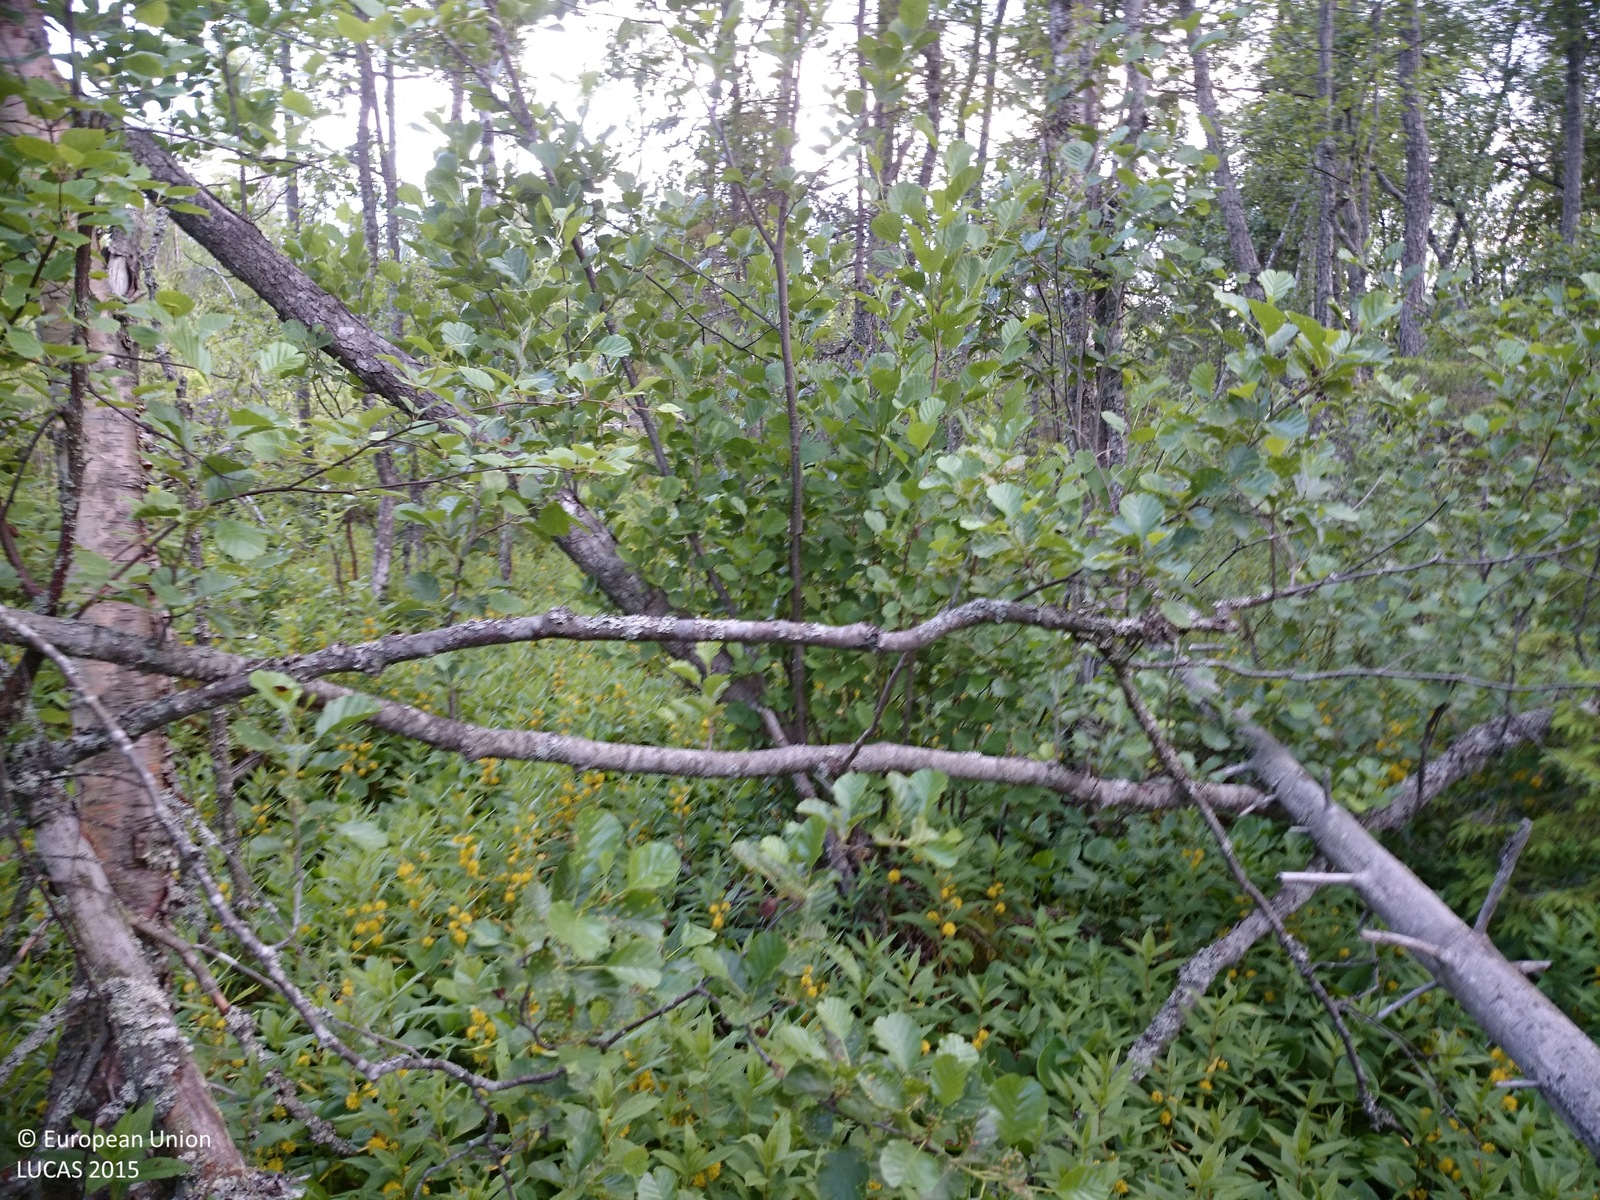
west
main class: Woodland
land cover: Broadleaved woodland
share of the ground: 50 - 75 %
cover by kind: broadleaved forest trees 45 %, herbaceous plants 40 %, coniferous forest trees 5 %
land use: Forestry
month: July
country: SE
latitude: 62.4387
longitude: 17.5942
